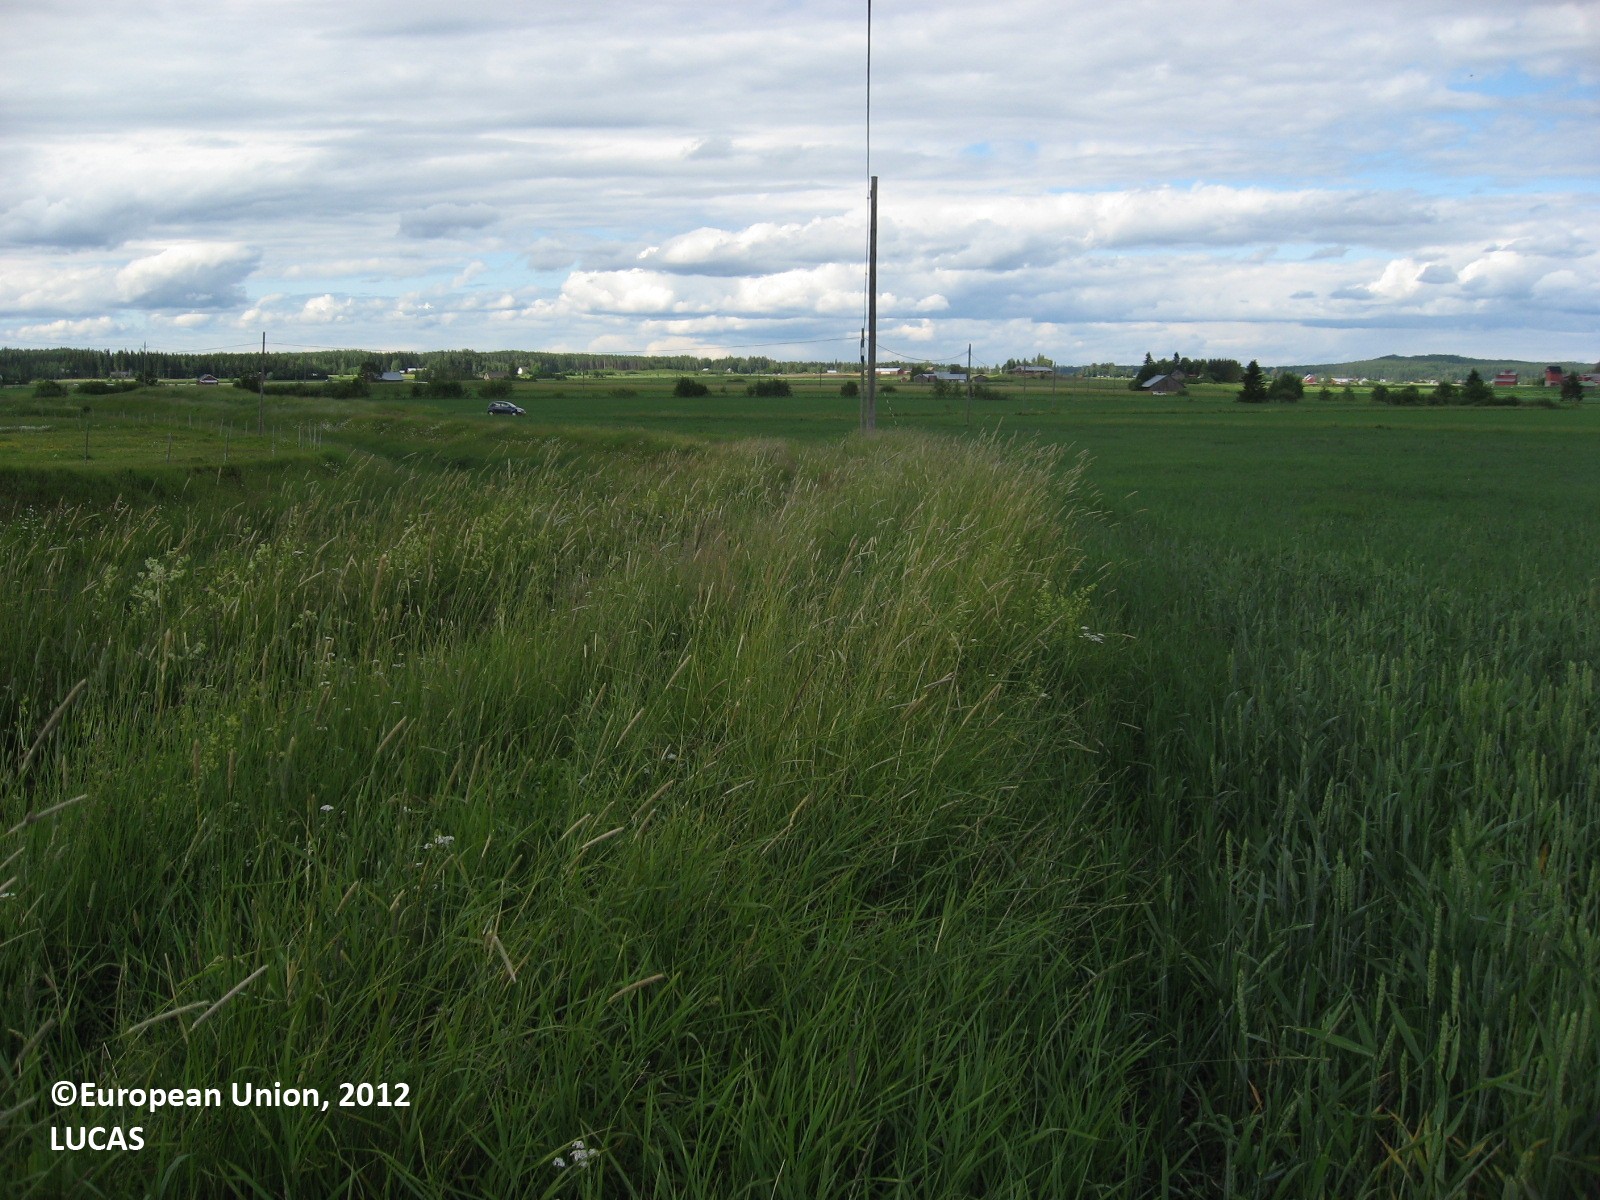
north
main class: Cropland
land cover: Common wheat
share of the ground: > 75 %
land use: Agriculture (excluding fallow land and kitchen gardens)
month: June
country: FI
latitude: 60.7358
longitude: 26.4560
